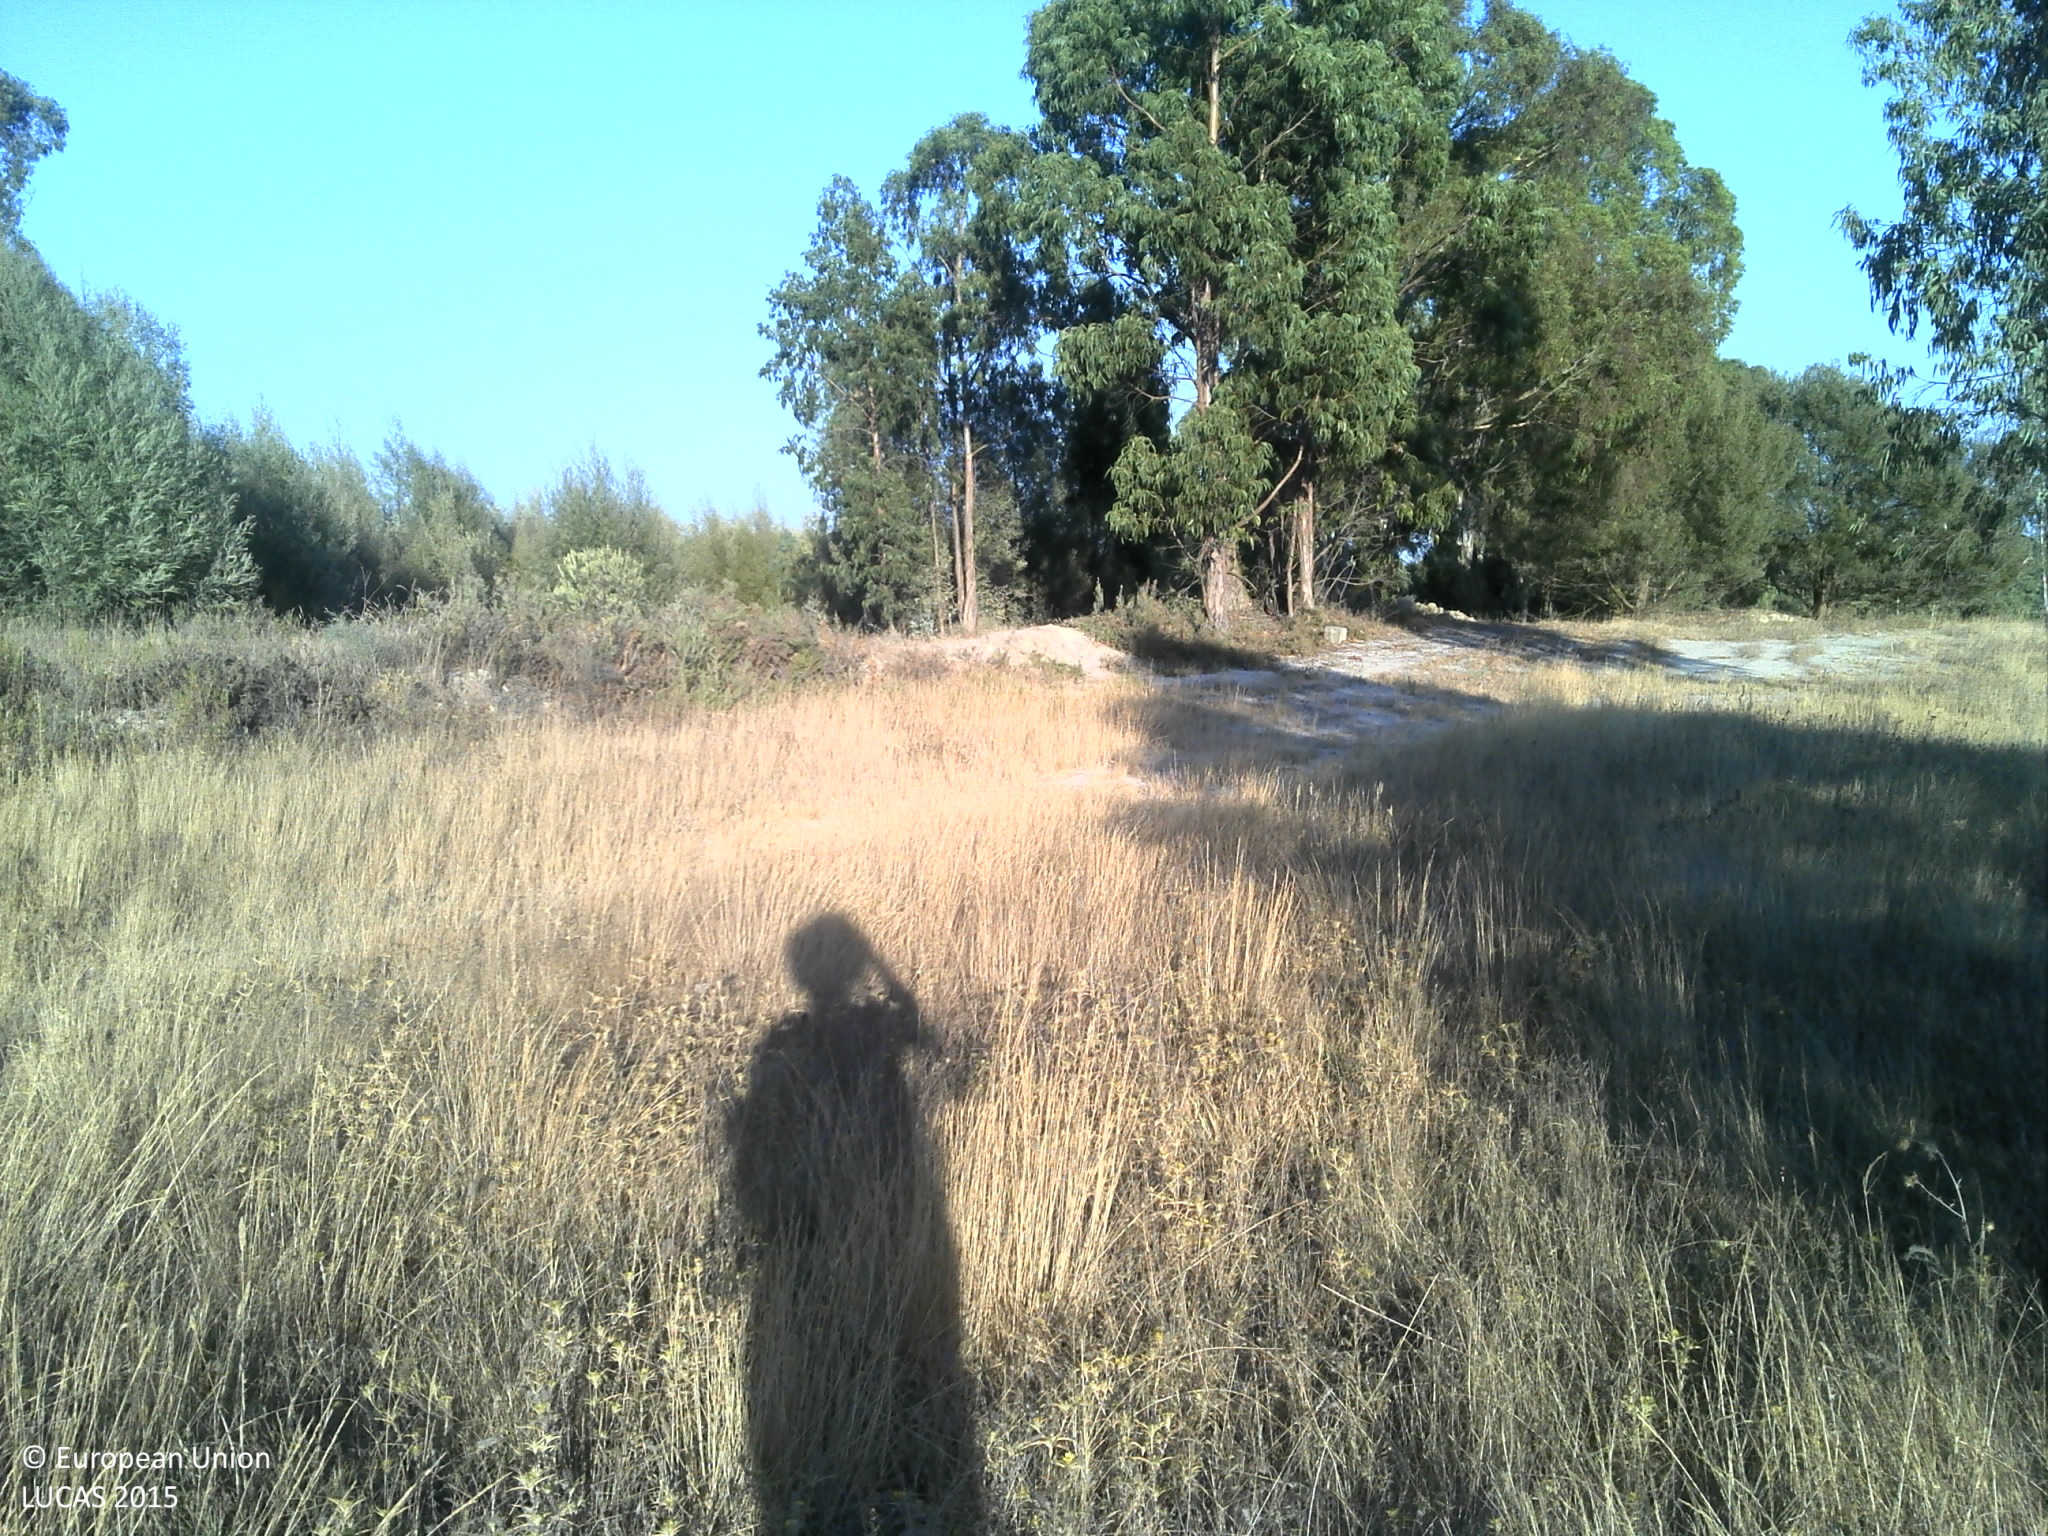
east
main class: Grassland
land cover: Spontaneously vegetated surfaces
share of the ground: > 75 %
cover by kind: herbaceous plants 90 %, unconsolidated bare surface 10 %
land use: Fallow land
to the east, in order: Spontaneously vegetated surfaces; Tracks; Grassland without tree/shrub cover; Broadleaved woodland; Spontaneously vegetated surfaces; Single bushes/trees; Vineyards; Tracks; Vineyards
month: August
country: PT
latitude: 38.6571
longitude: -8.5943
